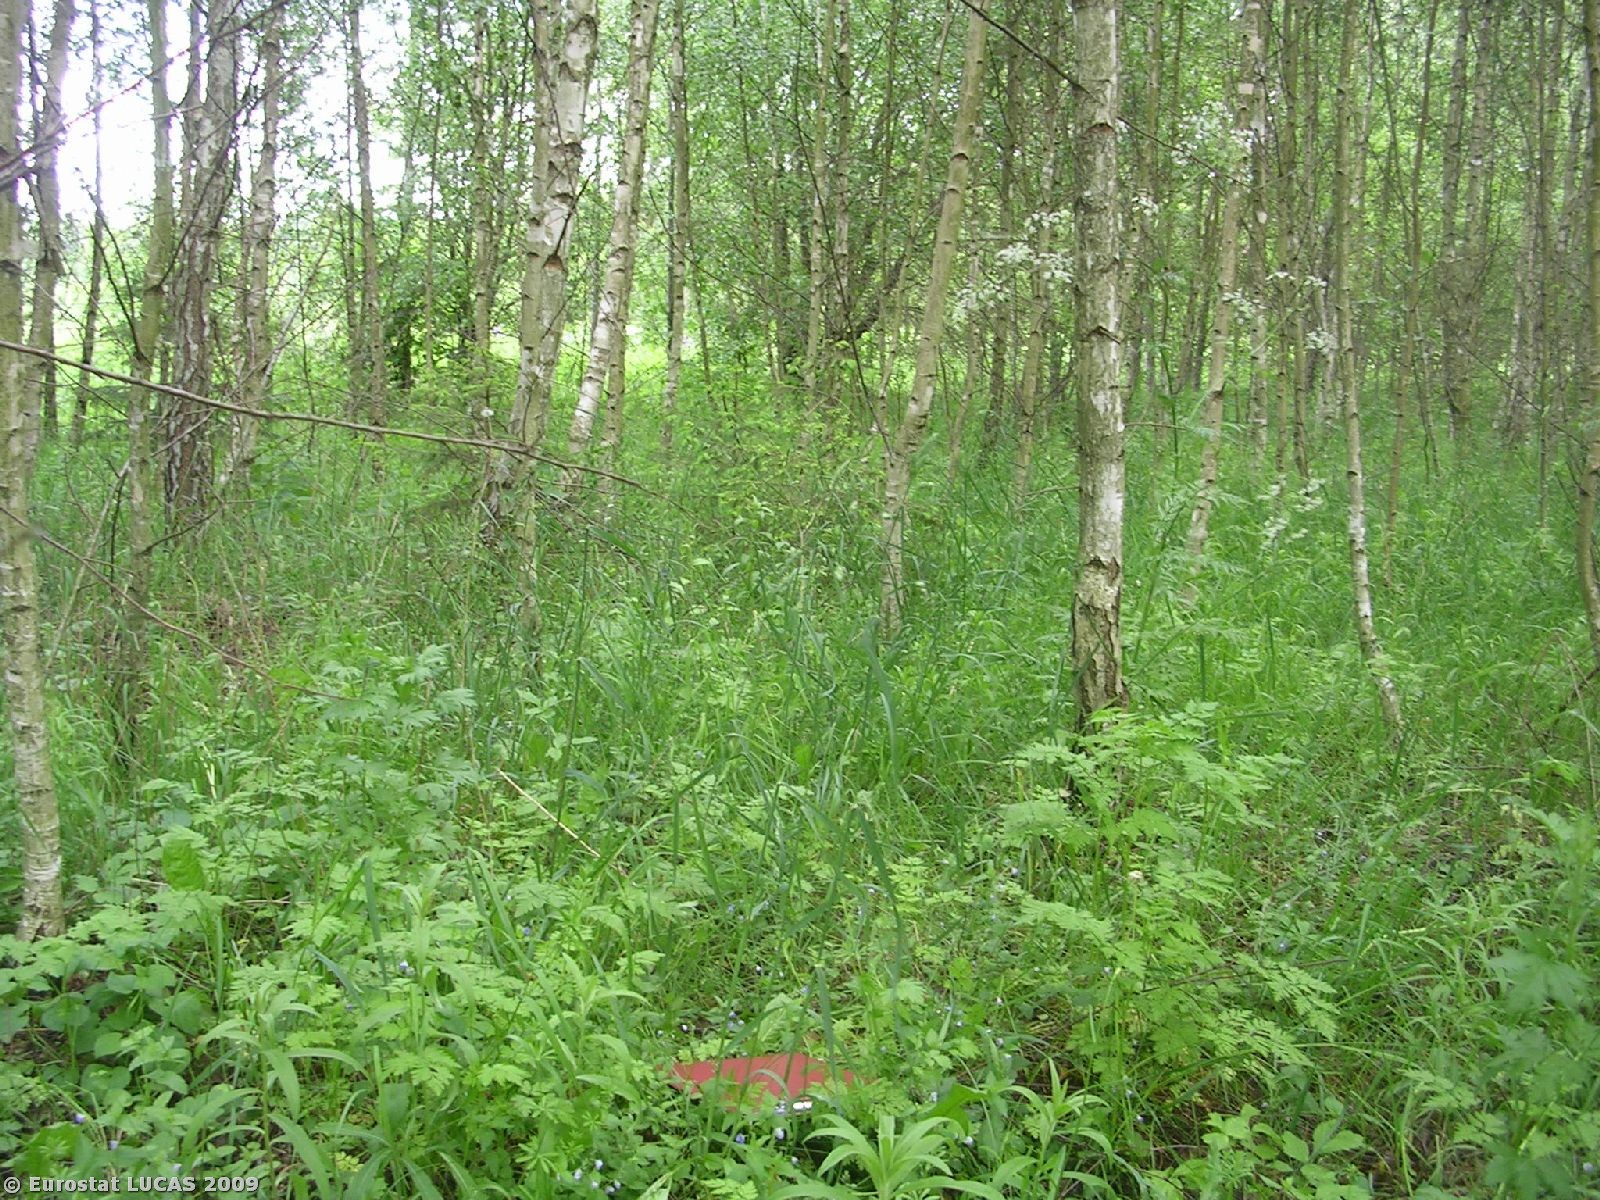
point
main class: Woodland
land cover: Broadleaved woodland
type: non-riverine alder, birch or aspen forest
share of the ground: 25 - 50 %
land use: Forestry
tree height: > 5 m
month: April
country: PL
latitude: 53.5960
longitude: 23.6088
